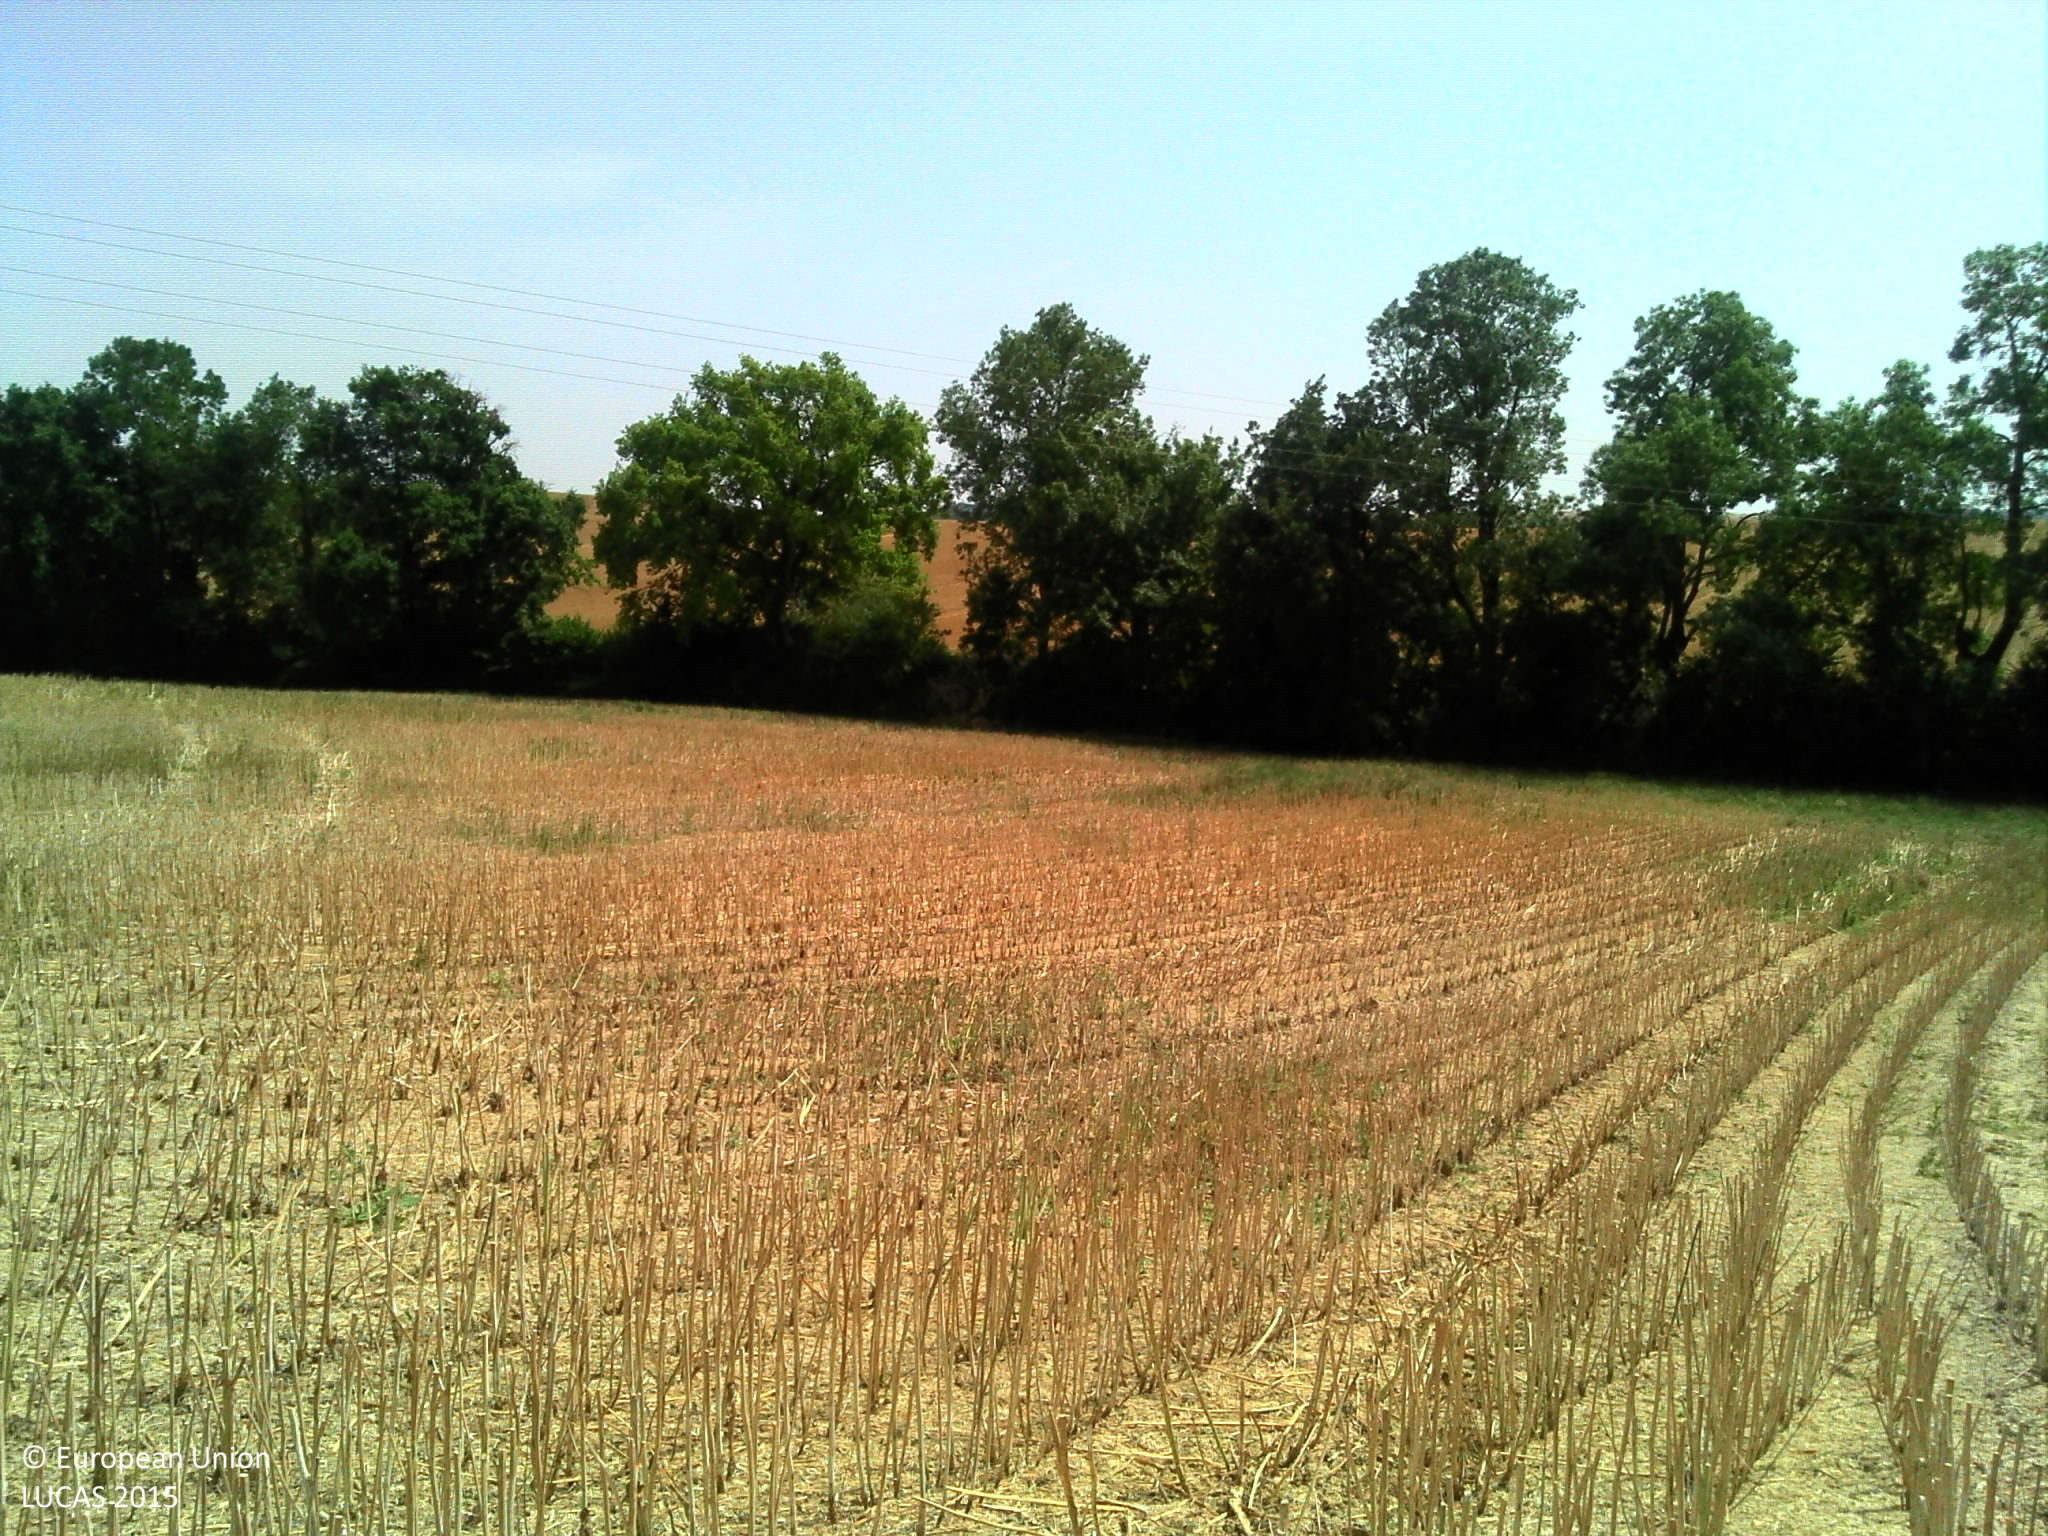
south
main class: Cropland
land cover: Rape and turnip rape
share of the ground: 10 - 25 %
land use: Agriculture (excluding fallow land and kitchen gardens)
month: July
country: FR
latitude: 43.6449
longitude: 0.9374
